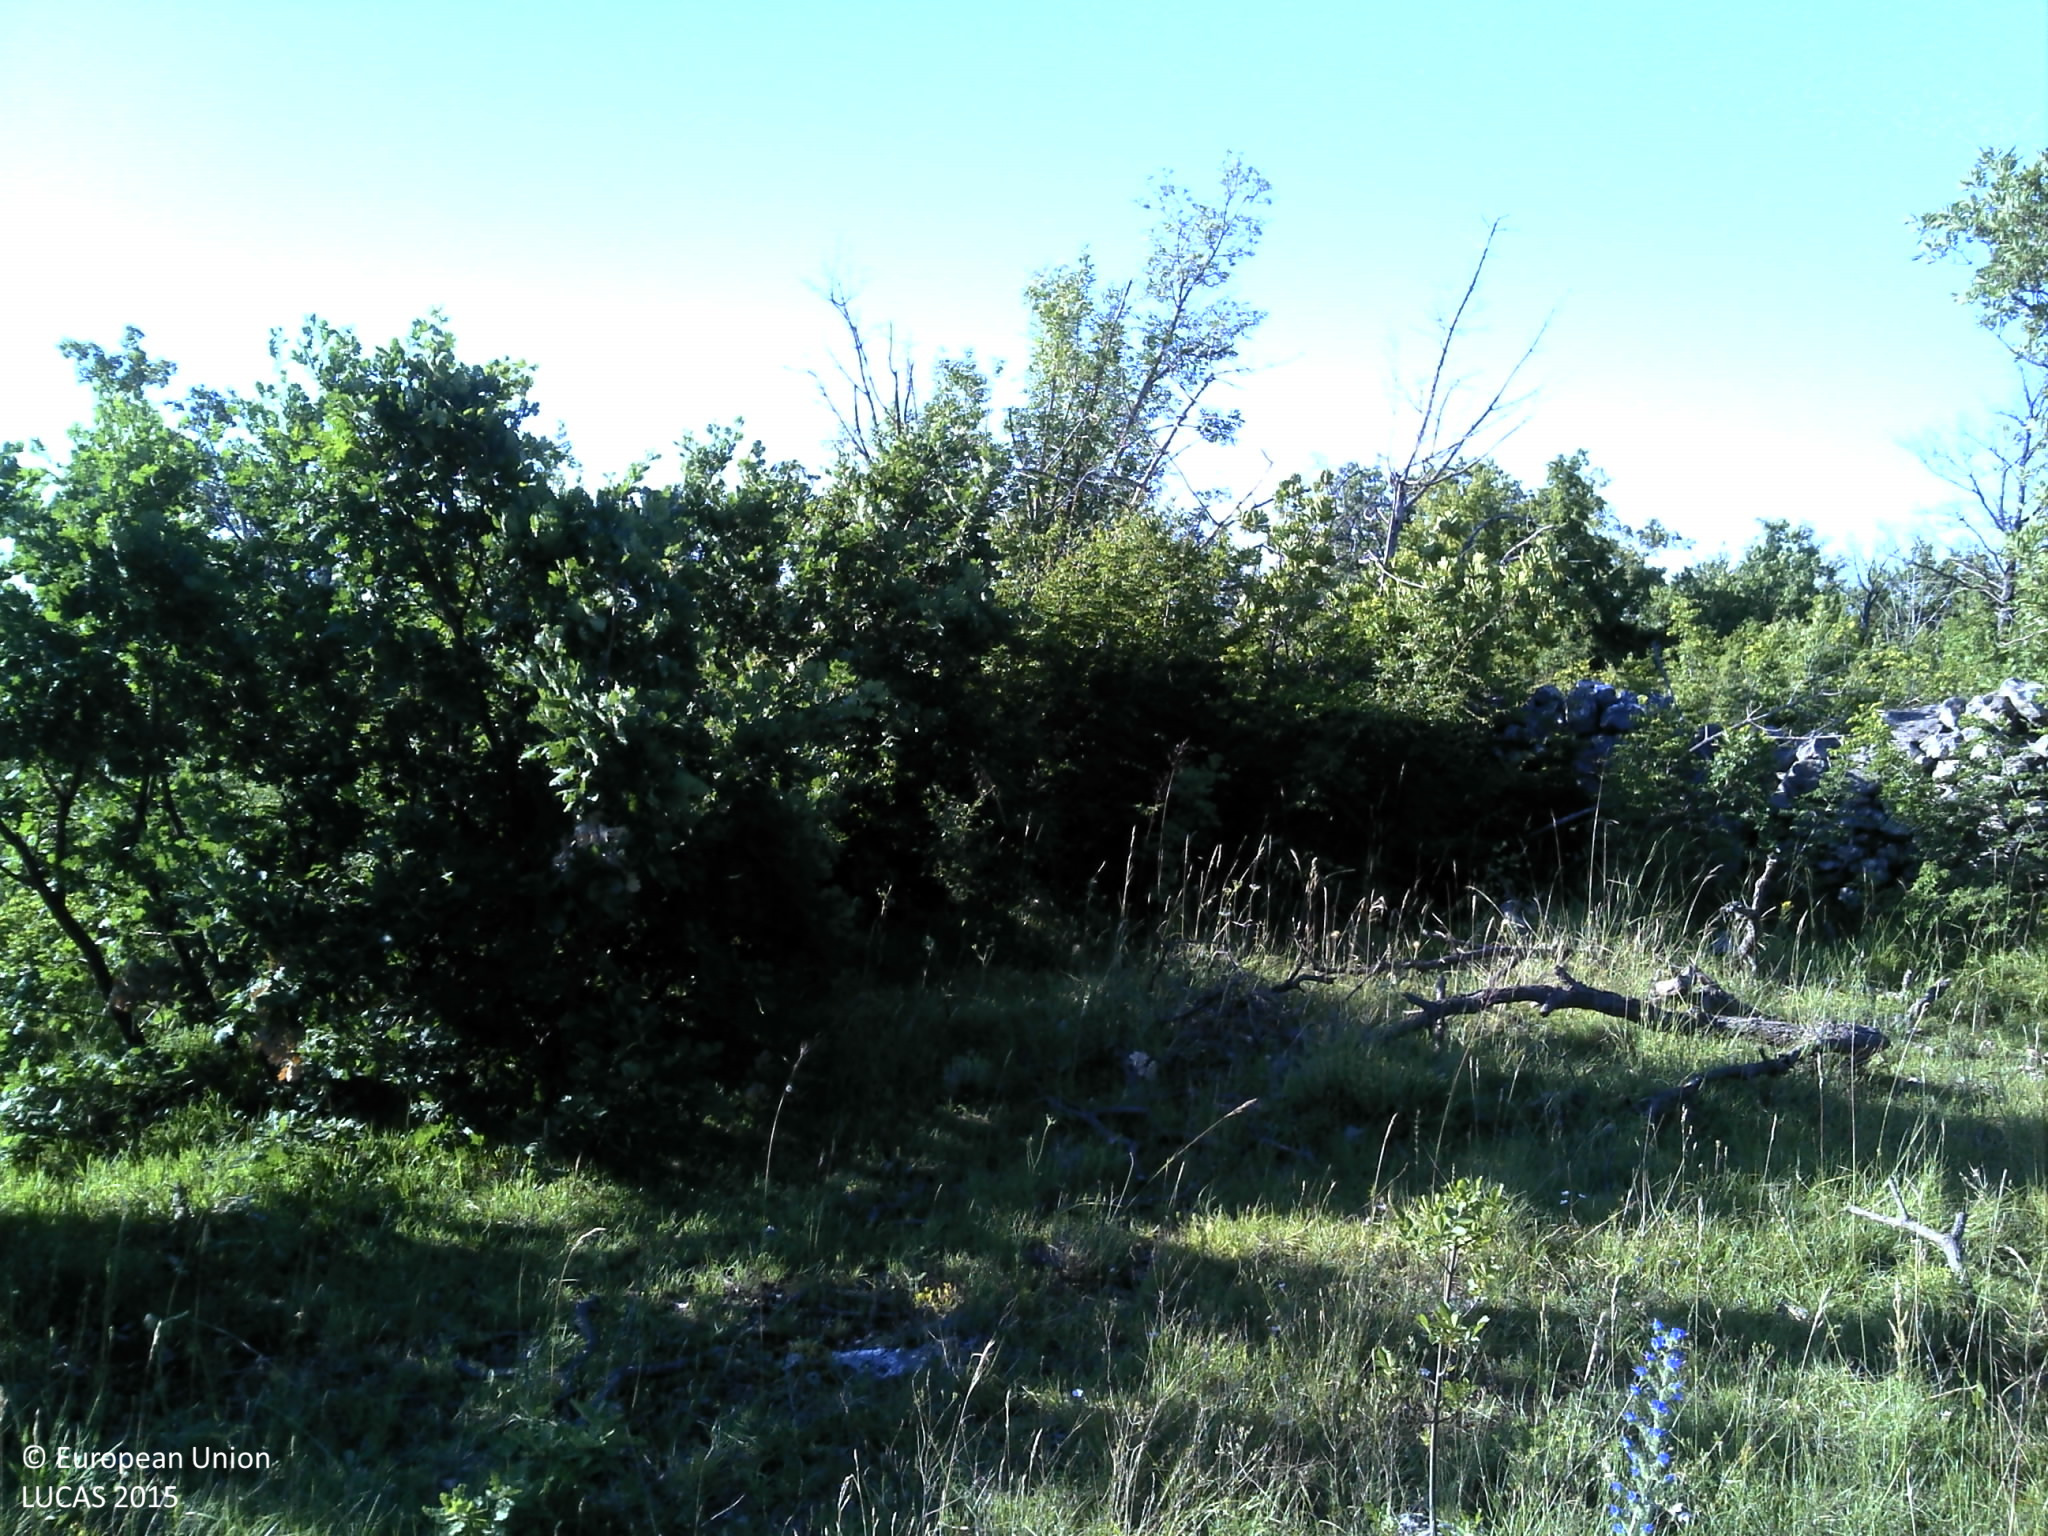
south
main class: Woodland
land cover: Broadleaved woodland
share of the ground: 25 - 50 %
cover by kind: broadleaved forest trees 30 %, shrubs 30 %, herbaceous plants 30 %, unconsolidated bare surface 10 %
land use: Semi-natural and natural areas not in use
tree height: > 5 m
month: June
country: HR
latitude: 44.0297
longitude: 16.0437
